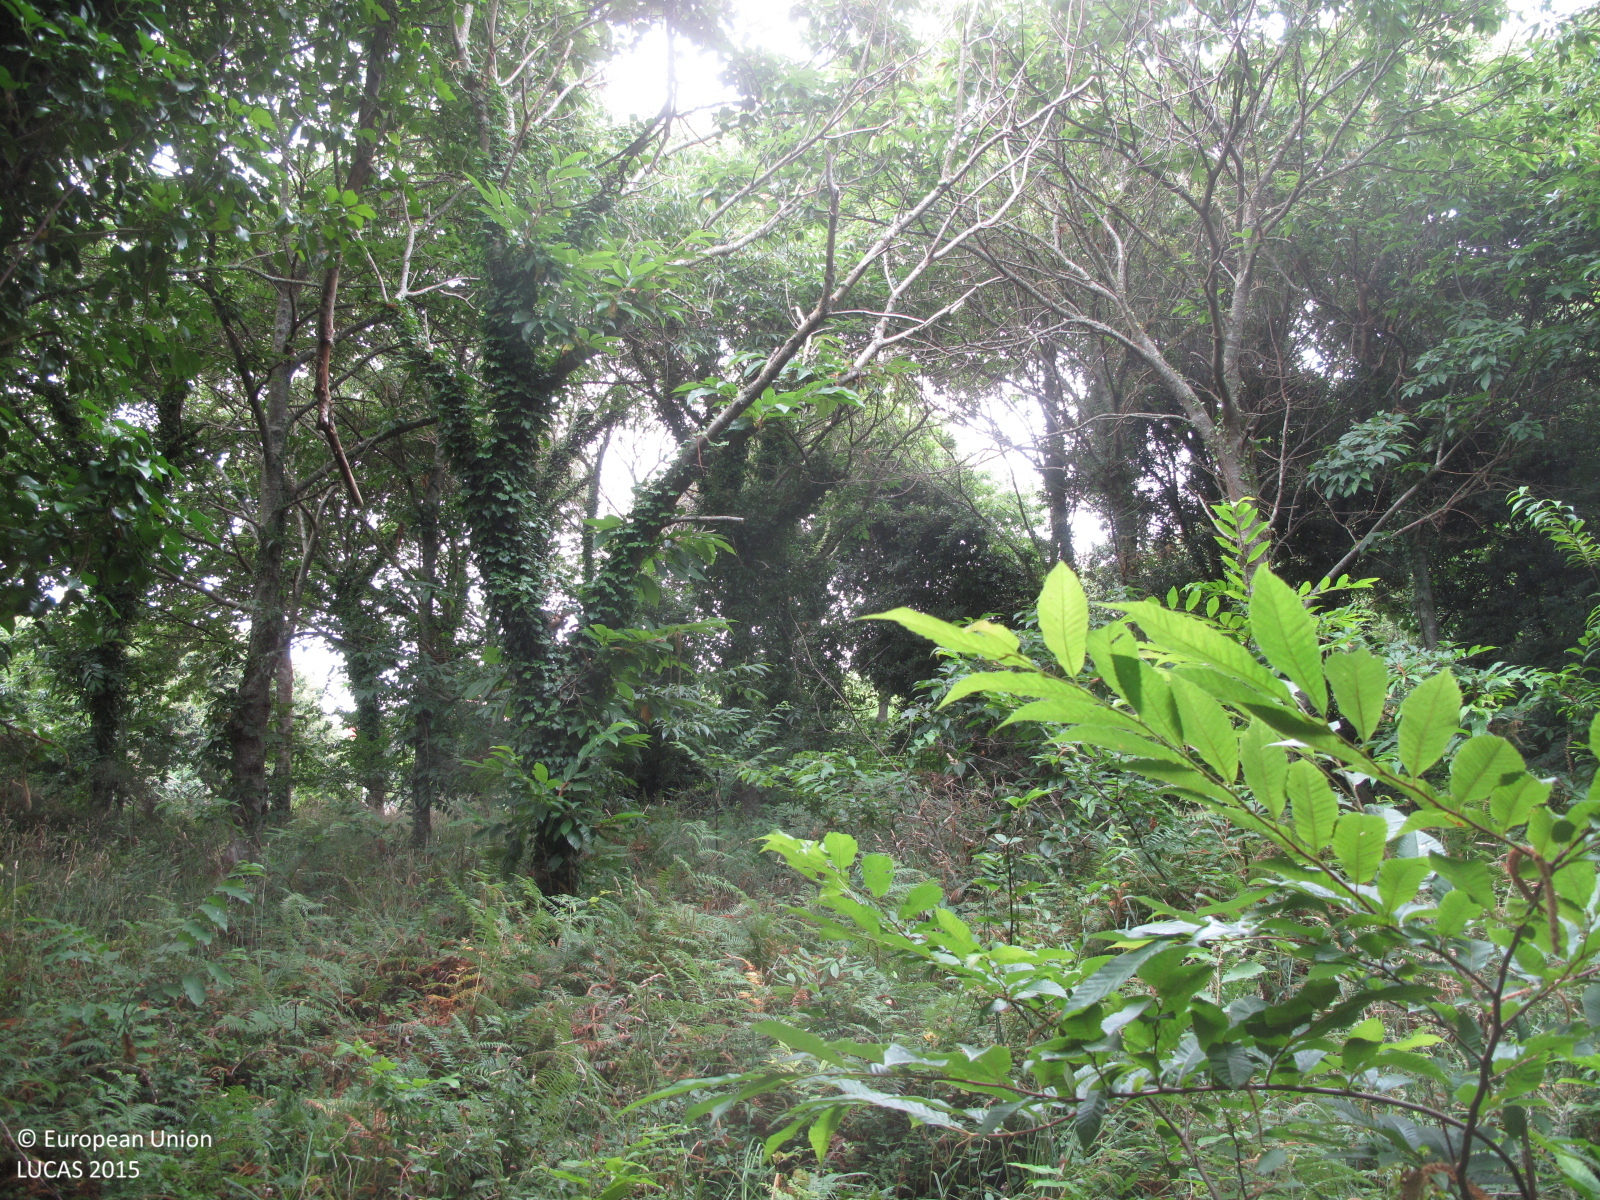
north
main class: Woodland
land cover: Broadleaved woodland
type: thermophilous deciduous forest
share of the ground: > 75 %
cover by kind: broadleaved forest trees 90 %, shrubs 5 %, herbaceous plants 5 %
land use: Forestry
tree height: > 5 m
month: July
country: ES
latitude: 43.1387
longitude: -9.1475
